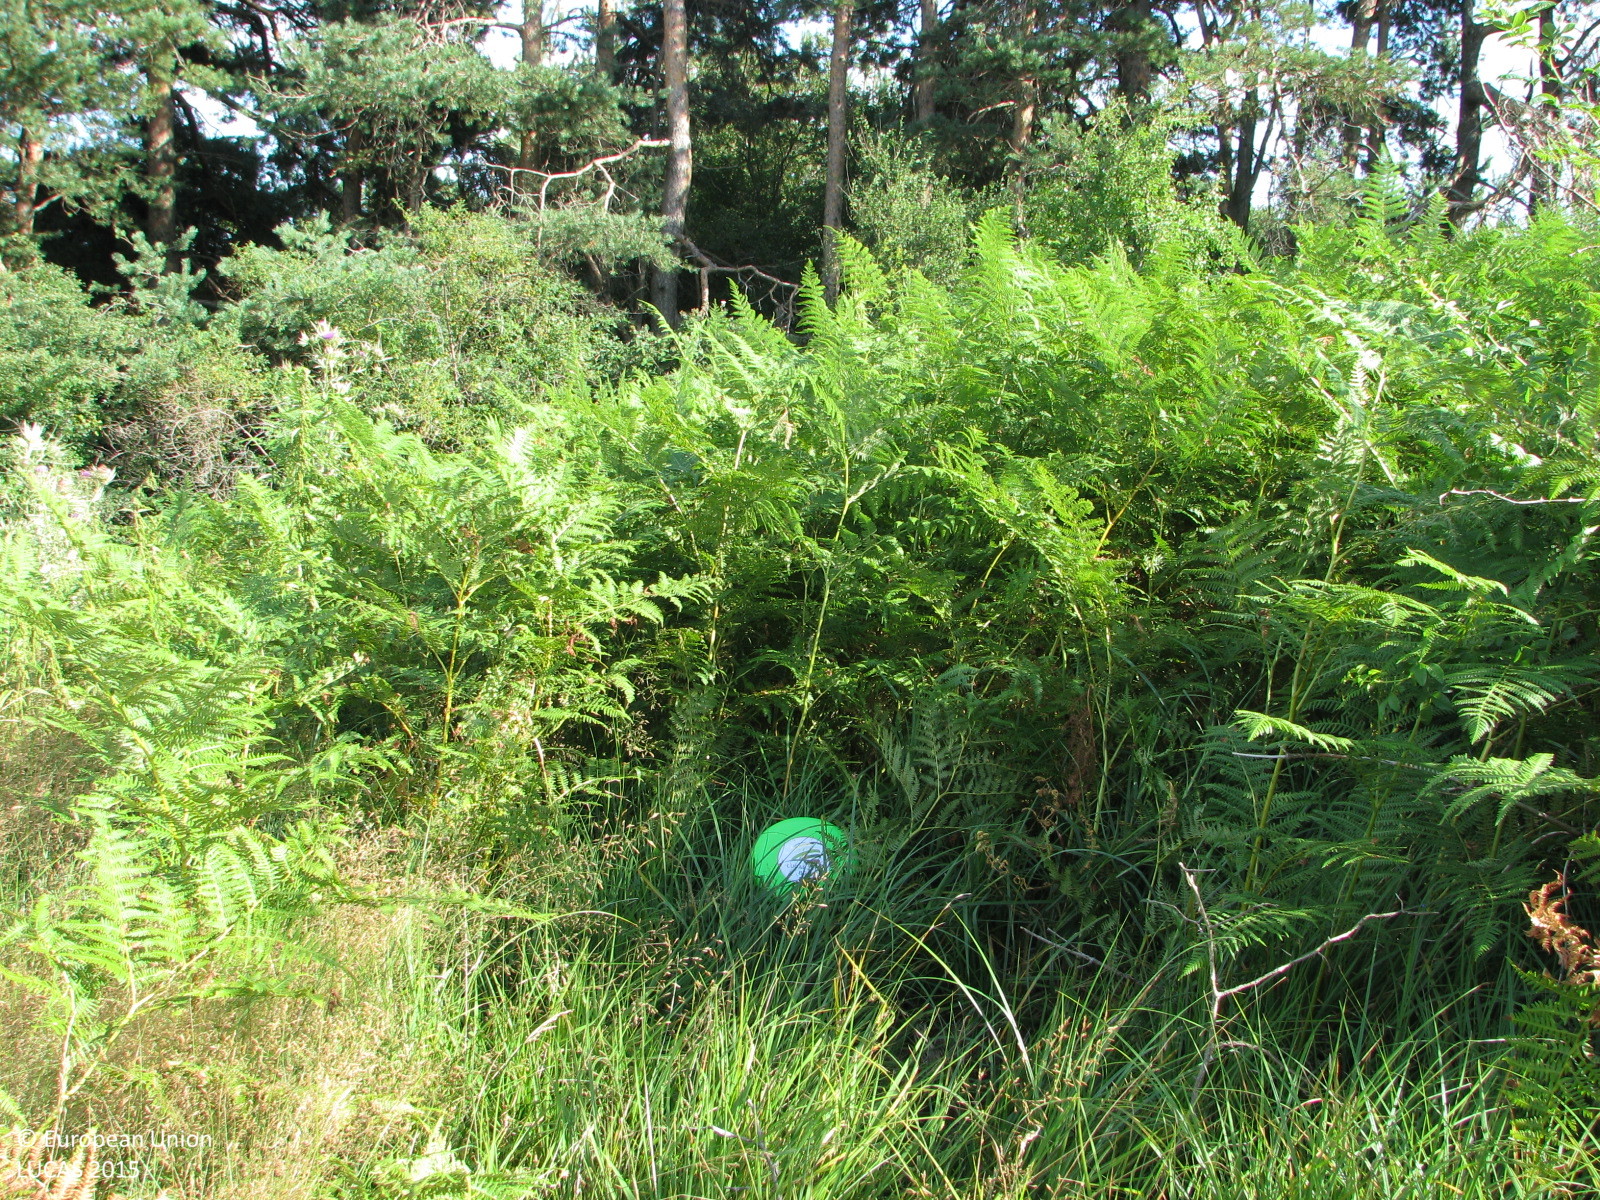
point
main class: Shrubland
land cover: Shrubland with sparse tree cover
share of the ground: > 75 %
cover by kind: shrubs 75 %, herbaceous plants 20 %, coniferous forest trees 5 %
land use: Semi-natural and natural areas not in use
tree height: > 5 m
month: August
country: BG
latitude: 42.8032
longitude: 26.2430
